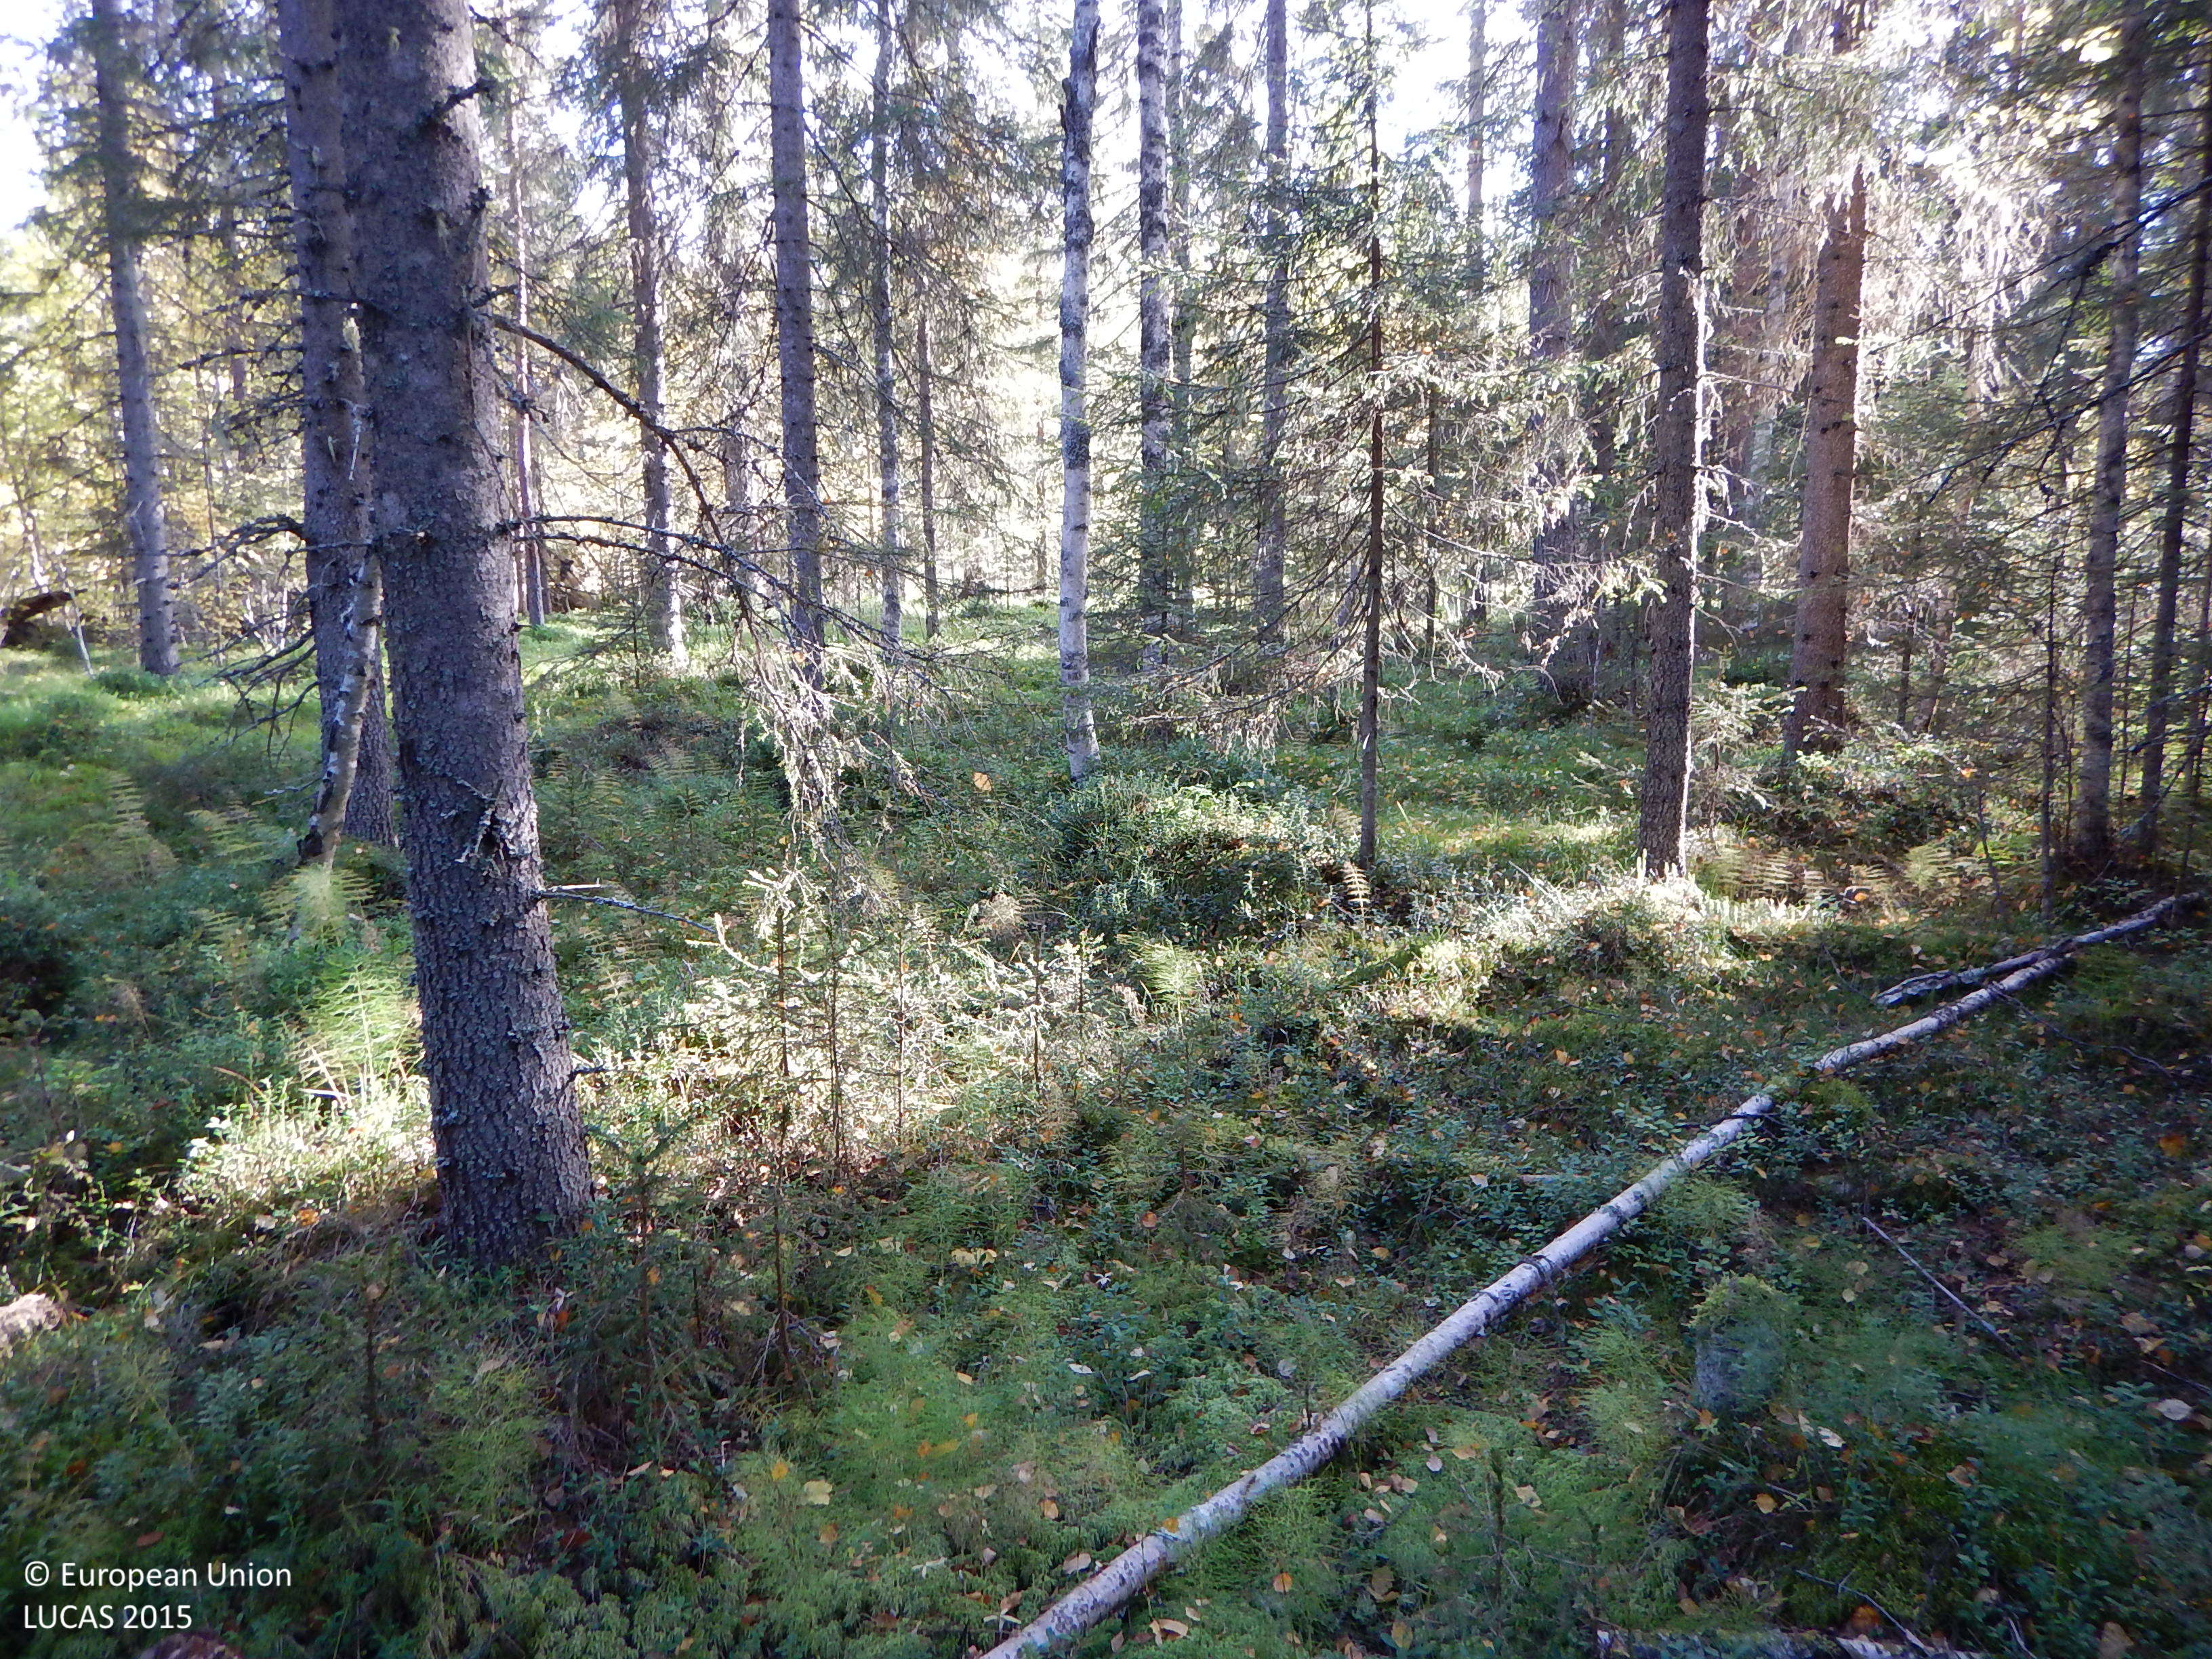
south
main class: Woodland
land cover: Spruce dominated coniferous woodland
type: boreal forest
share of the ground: 50 - 75 %
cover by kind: coniferous forest trees 50 %, shrubs 15 %, lichens and mosses 15 %, broadleaved forest trees 10 %, herbaceous plants 10 %
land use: Forestry
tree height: > 5 m
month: September
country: SE
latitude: 64.6955
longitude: 20.1005
